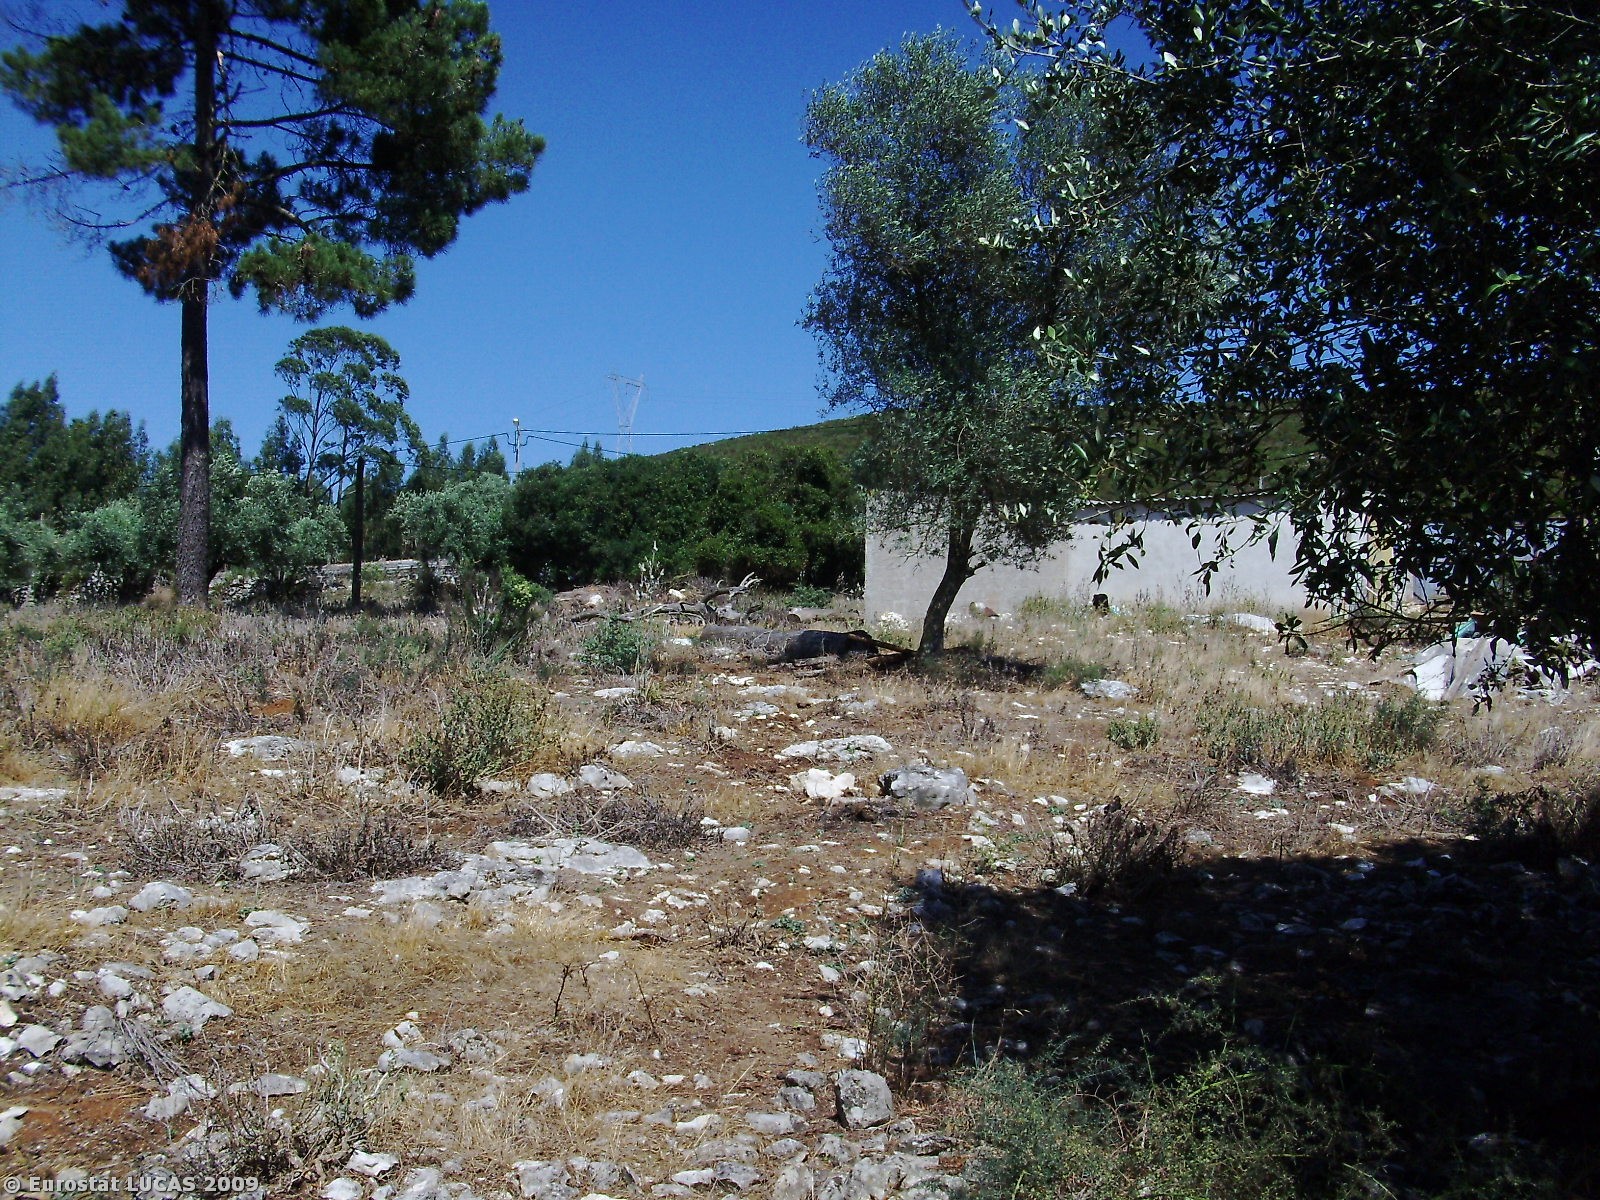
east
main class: Cropland
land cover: Olive groves
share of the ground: 10 - 25 %
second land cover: Spontaneously vegetated surfaces
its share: 25 - 50 %
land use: Agriculture (excluding fallow land and kitchen gardens)
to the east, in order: Olive groves; Spontaneously vegetated surfaces; Olive groves; Artificial constructions in urban areas; Fences; Tracks; Electric lines; Spontaneously vegetated surfaces; Paved roads, cycling and walking lanes; Electric lines; Shrubland with sparse tree cover; Dry stone walls; Broadleaved woodland; Dry stone walls; Shrubland with sparse tree cover
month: July
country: PT
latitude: 39.4797
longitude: -8.9294
